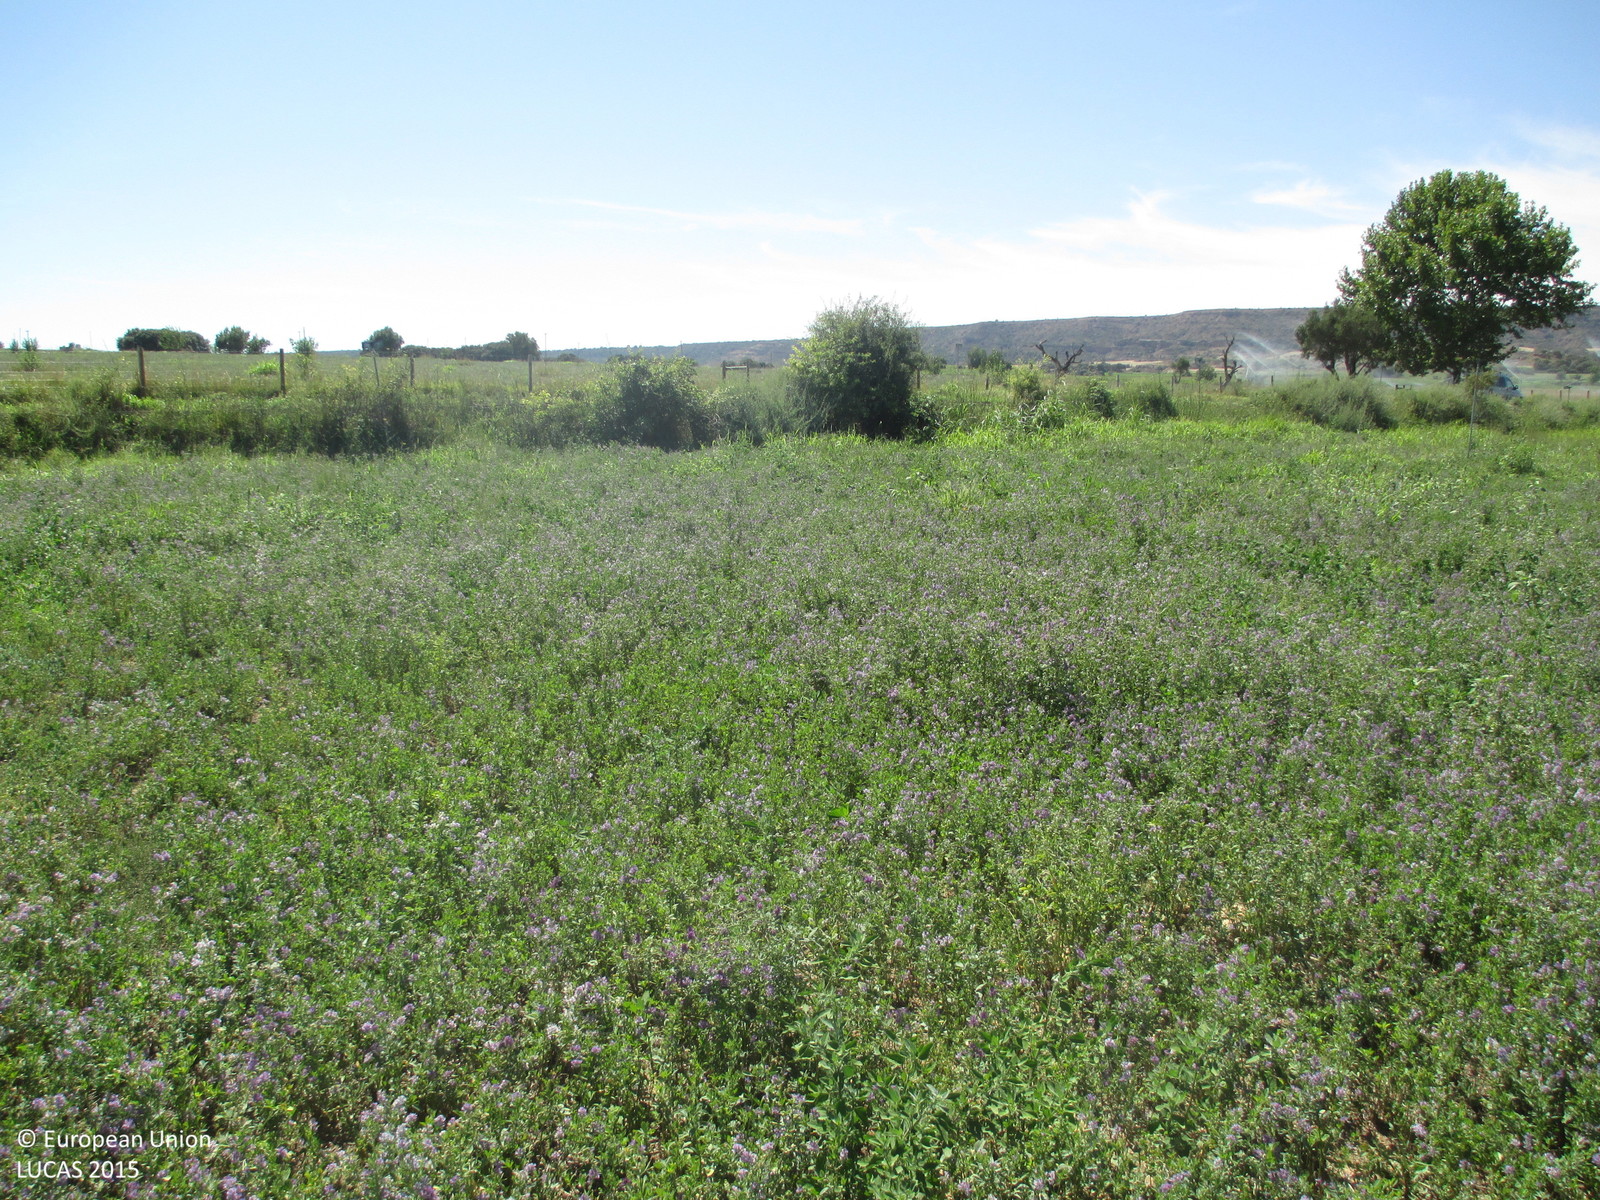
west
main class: Cropland
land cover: Lucerne
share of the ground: > 75 %
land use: Agriculture (excluding fallow land and kitchen gardens)
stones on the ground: < 10 %
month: July
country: ES
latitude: 41.9273
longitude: 0.0576
